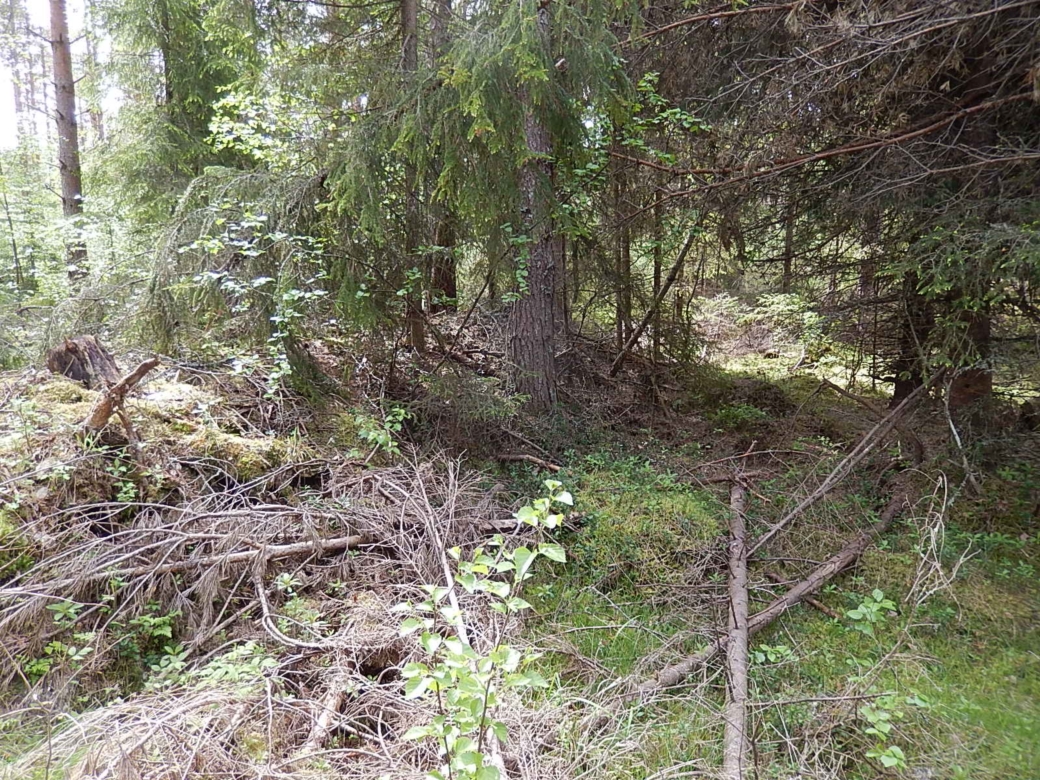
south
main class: Woodland
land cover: Other coniferous woodland
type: boreal forest
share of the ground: > 75 %
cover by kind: coniferous forest trees 70 %, broadleaved forest trees 10 %, shrubs 10 %, herbaceous plants 10 %
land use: Forestry
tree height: > 5 m
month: June
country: FI
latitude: 61.9155
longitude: 21.4912
